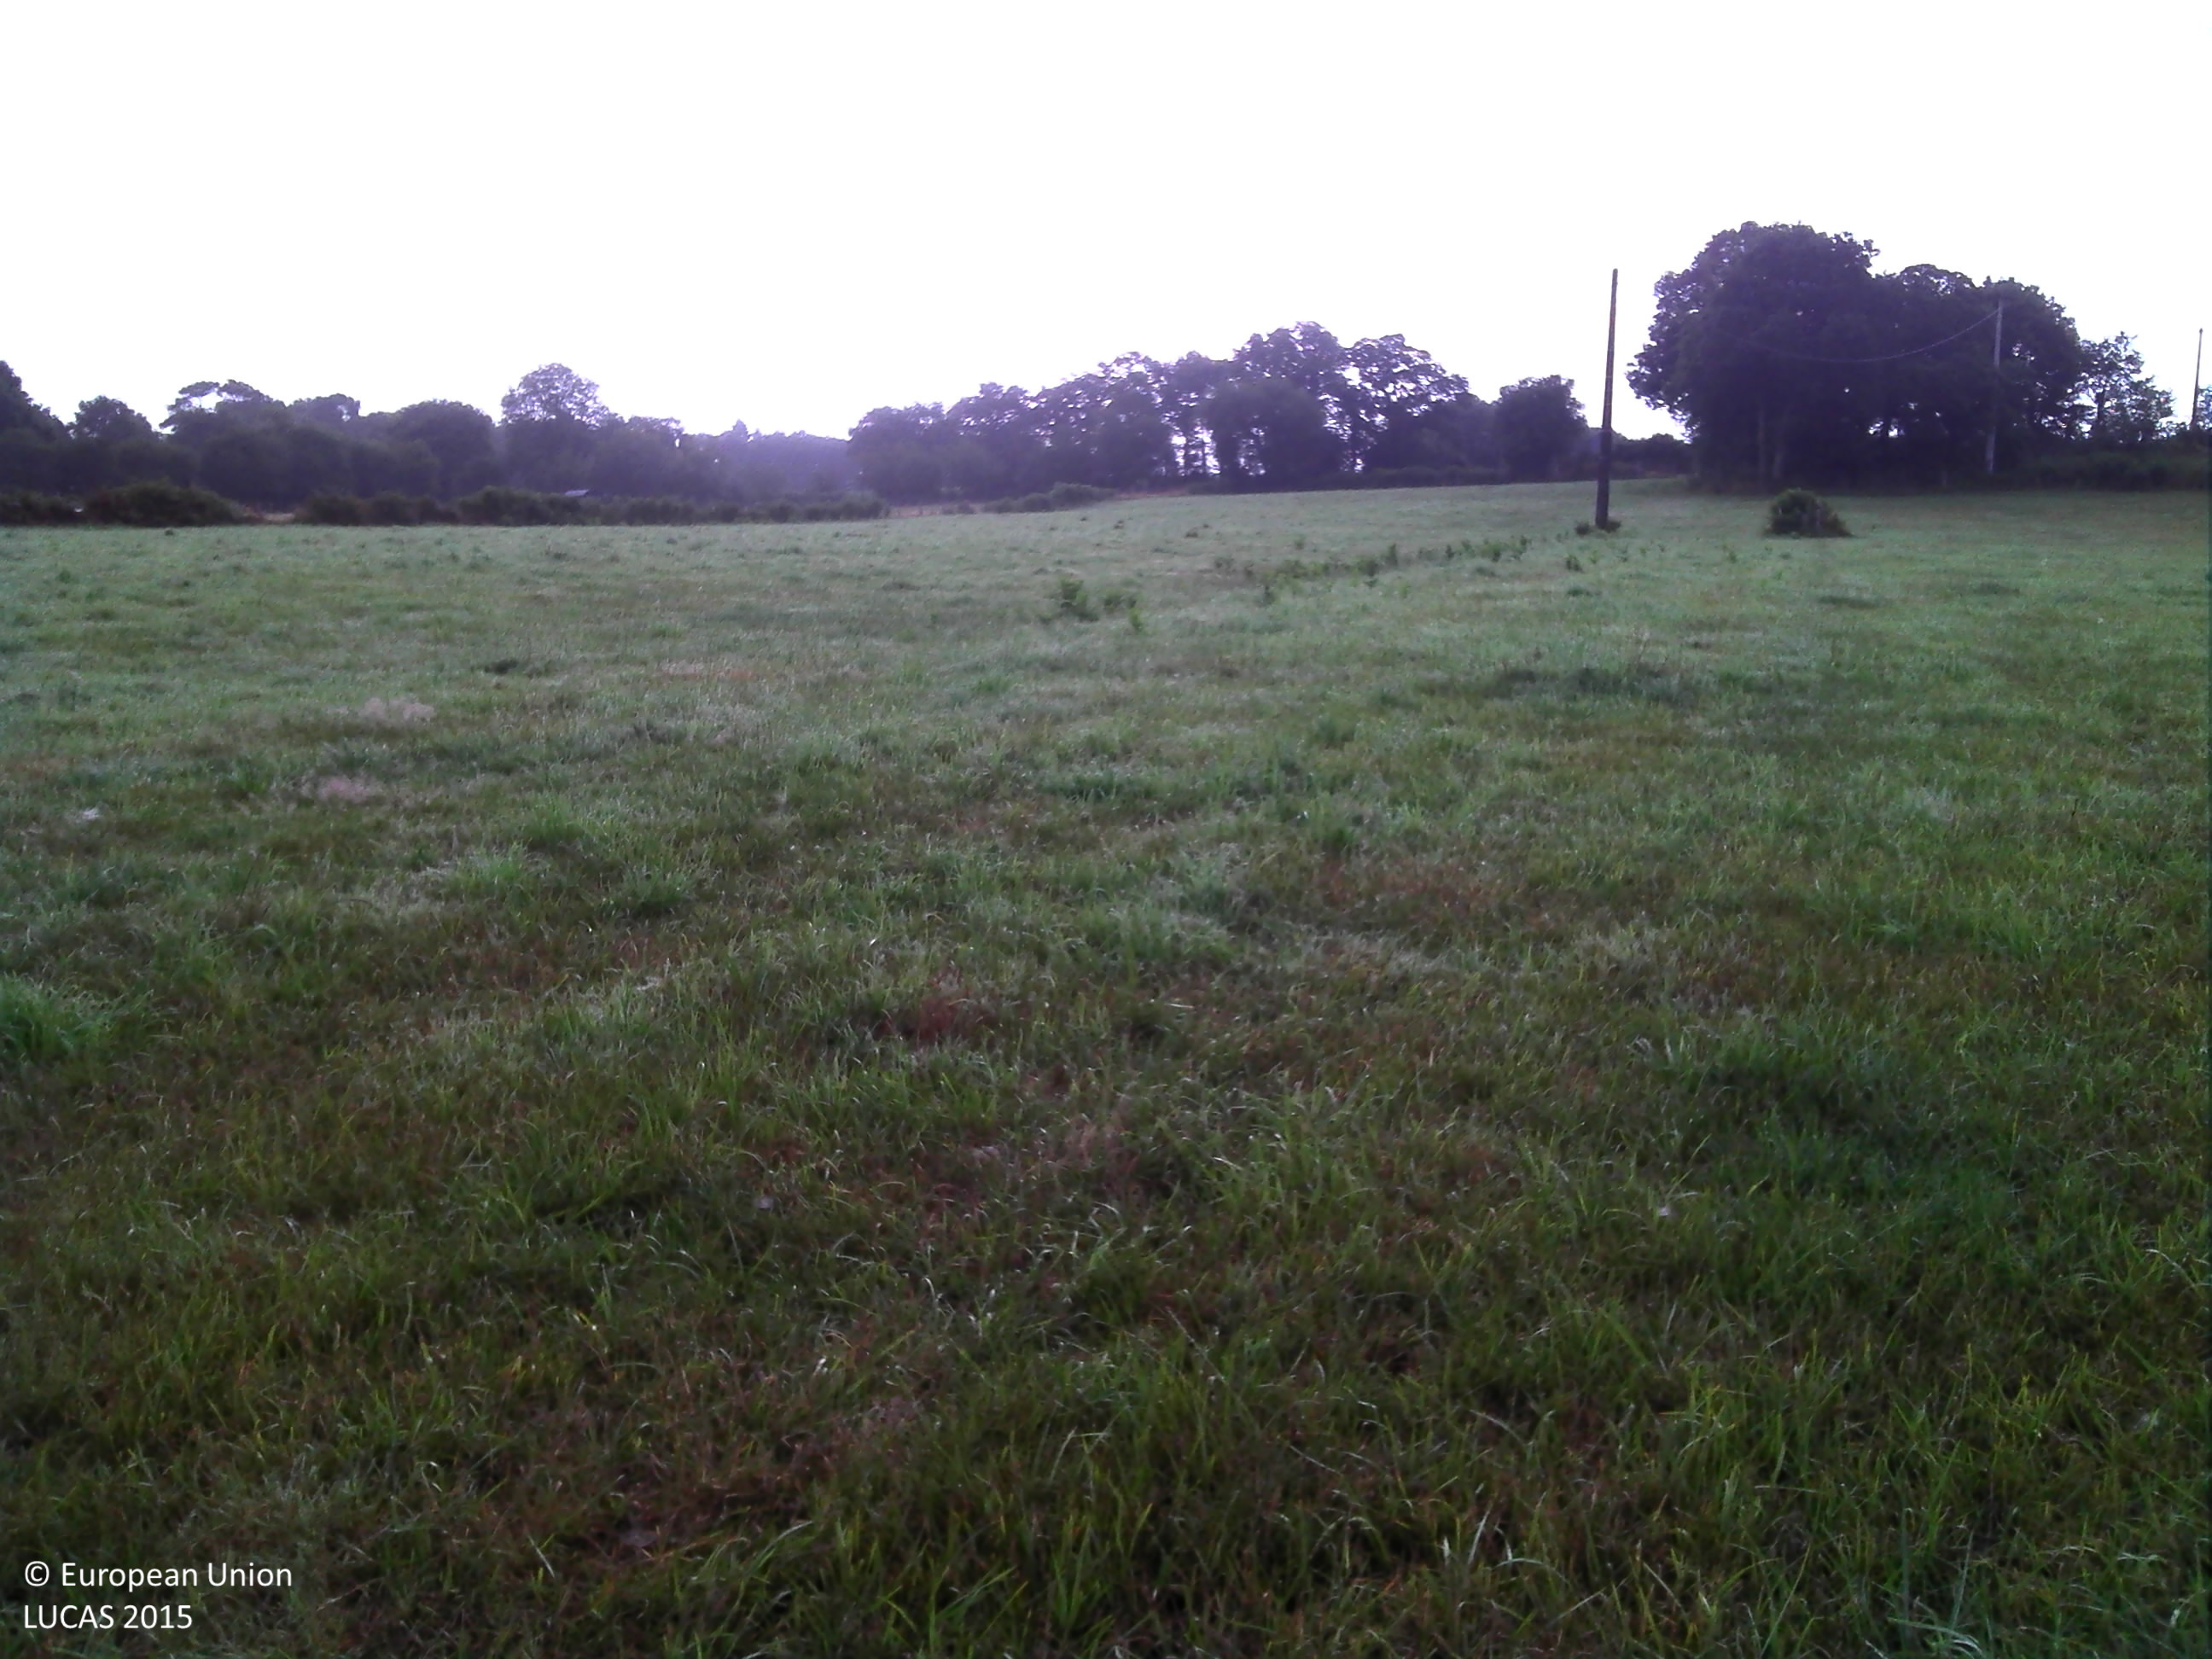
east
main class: Grassland
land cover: Grassland without tree/shrub cover
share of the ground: > 75 %
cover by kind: herbaceous plants 80 %, unconsolidated bare surface 20 %
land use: Agriculture (excluding fallow land and kitchen gardens)
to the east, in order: Grassland without tree/shrub cover; Electric lines; Grassland without tree/shrub cover; Fences; Grassland without tree/shrub cover; Lines of trees; Grassland without tree/shrub cover; Fences; Grass margins; Paved roads, cycling and walking lanes; Grass margins; Ditches and canals; Electric lines; Lines of trees; Maize
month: July
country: FR
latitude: 47.7427
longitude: -2.9894
